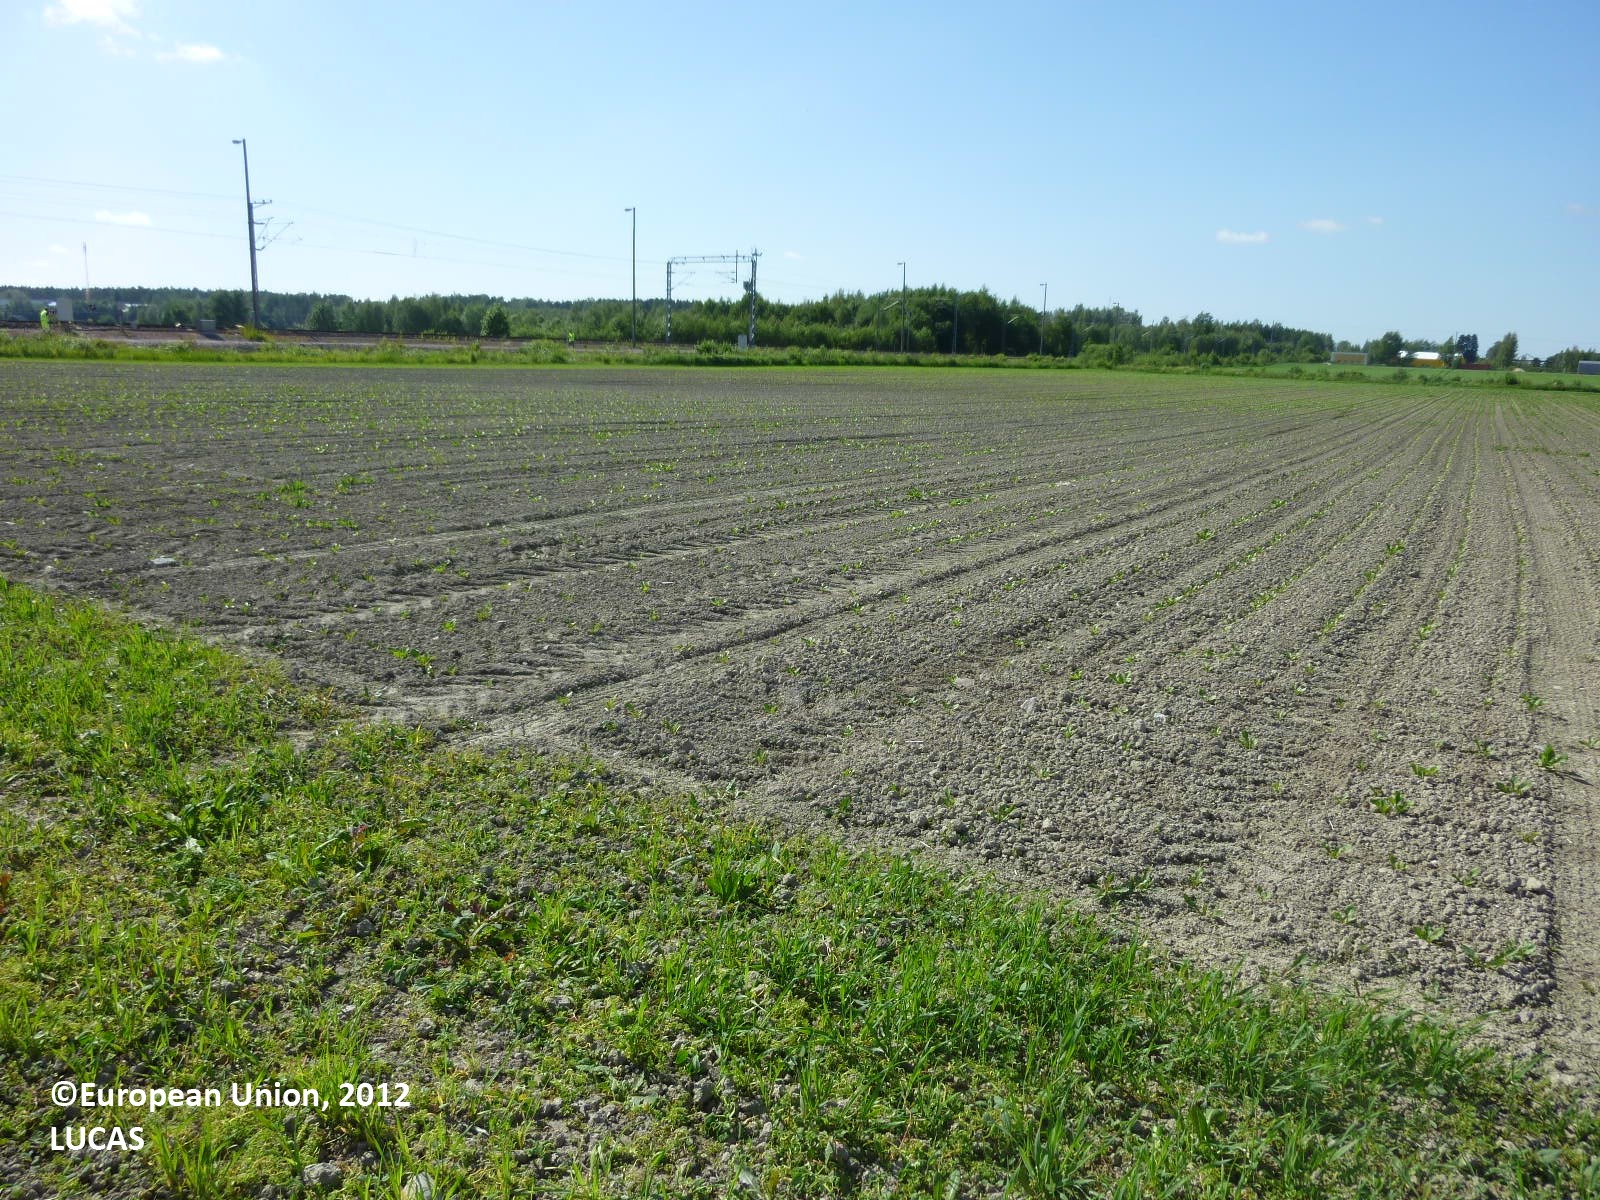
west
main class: Grassland
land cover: Spontaneously vegetated surfaces
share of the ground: 10 - 25 %
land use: Fallow land
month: July
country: FI
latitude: 61.3833
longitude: 21.9796
